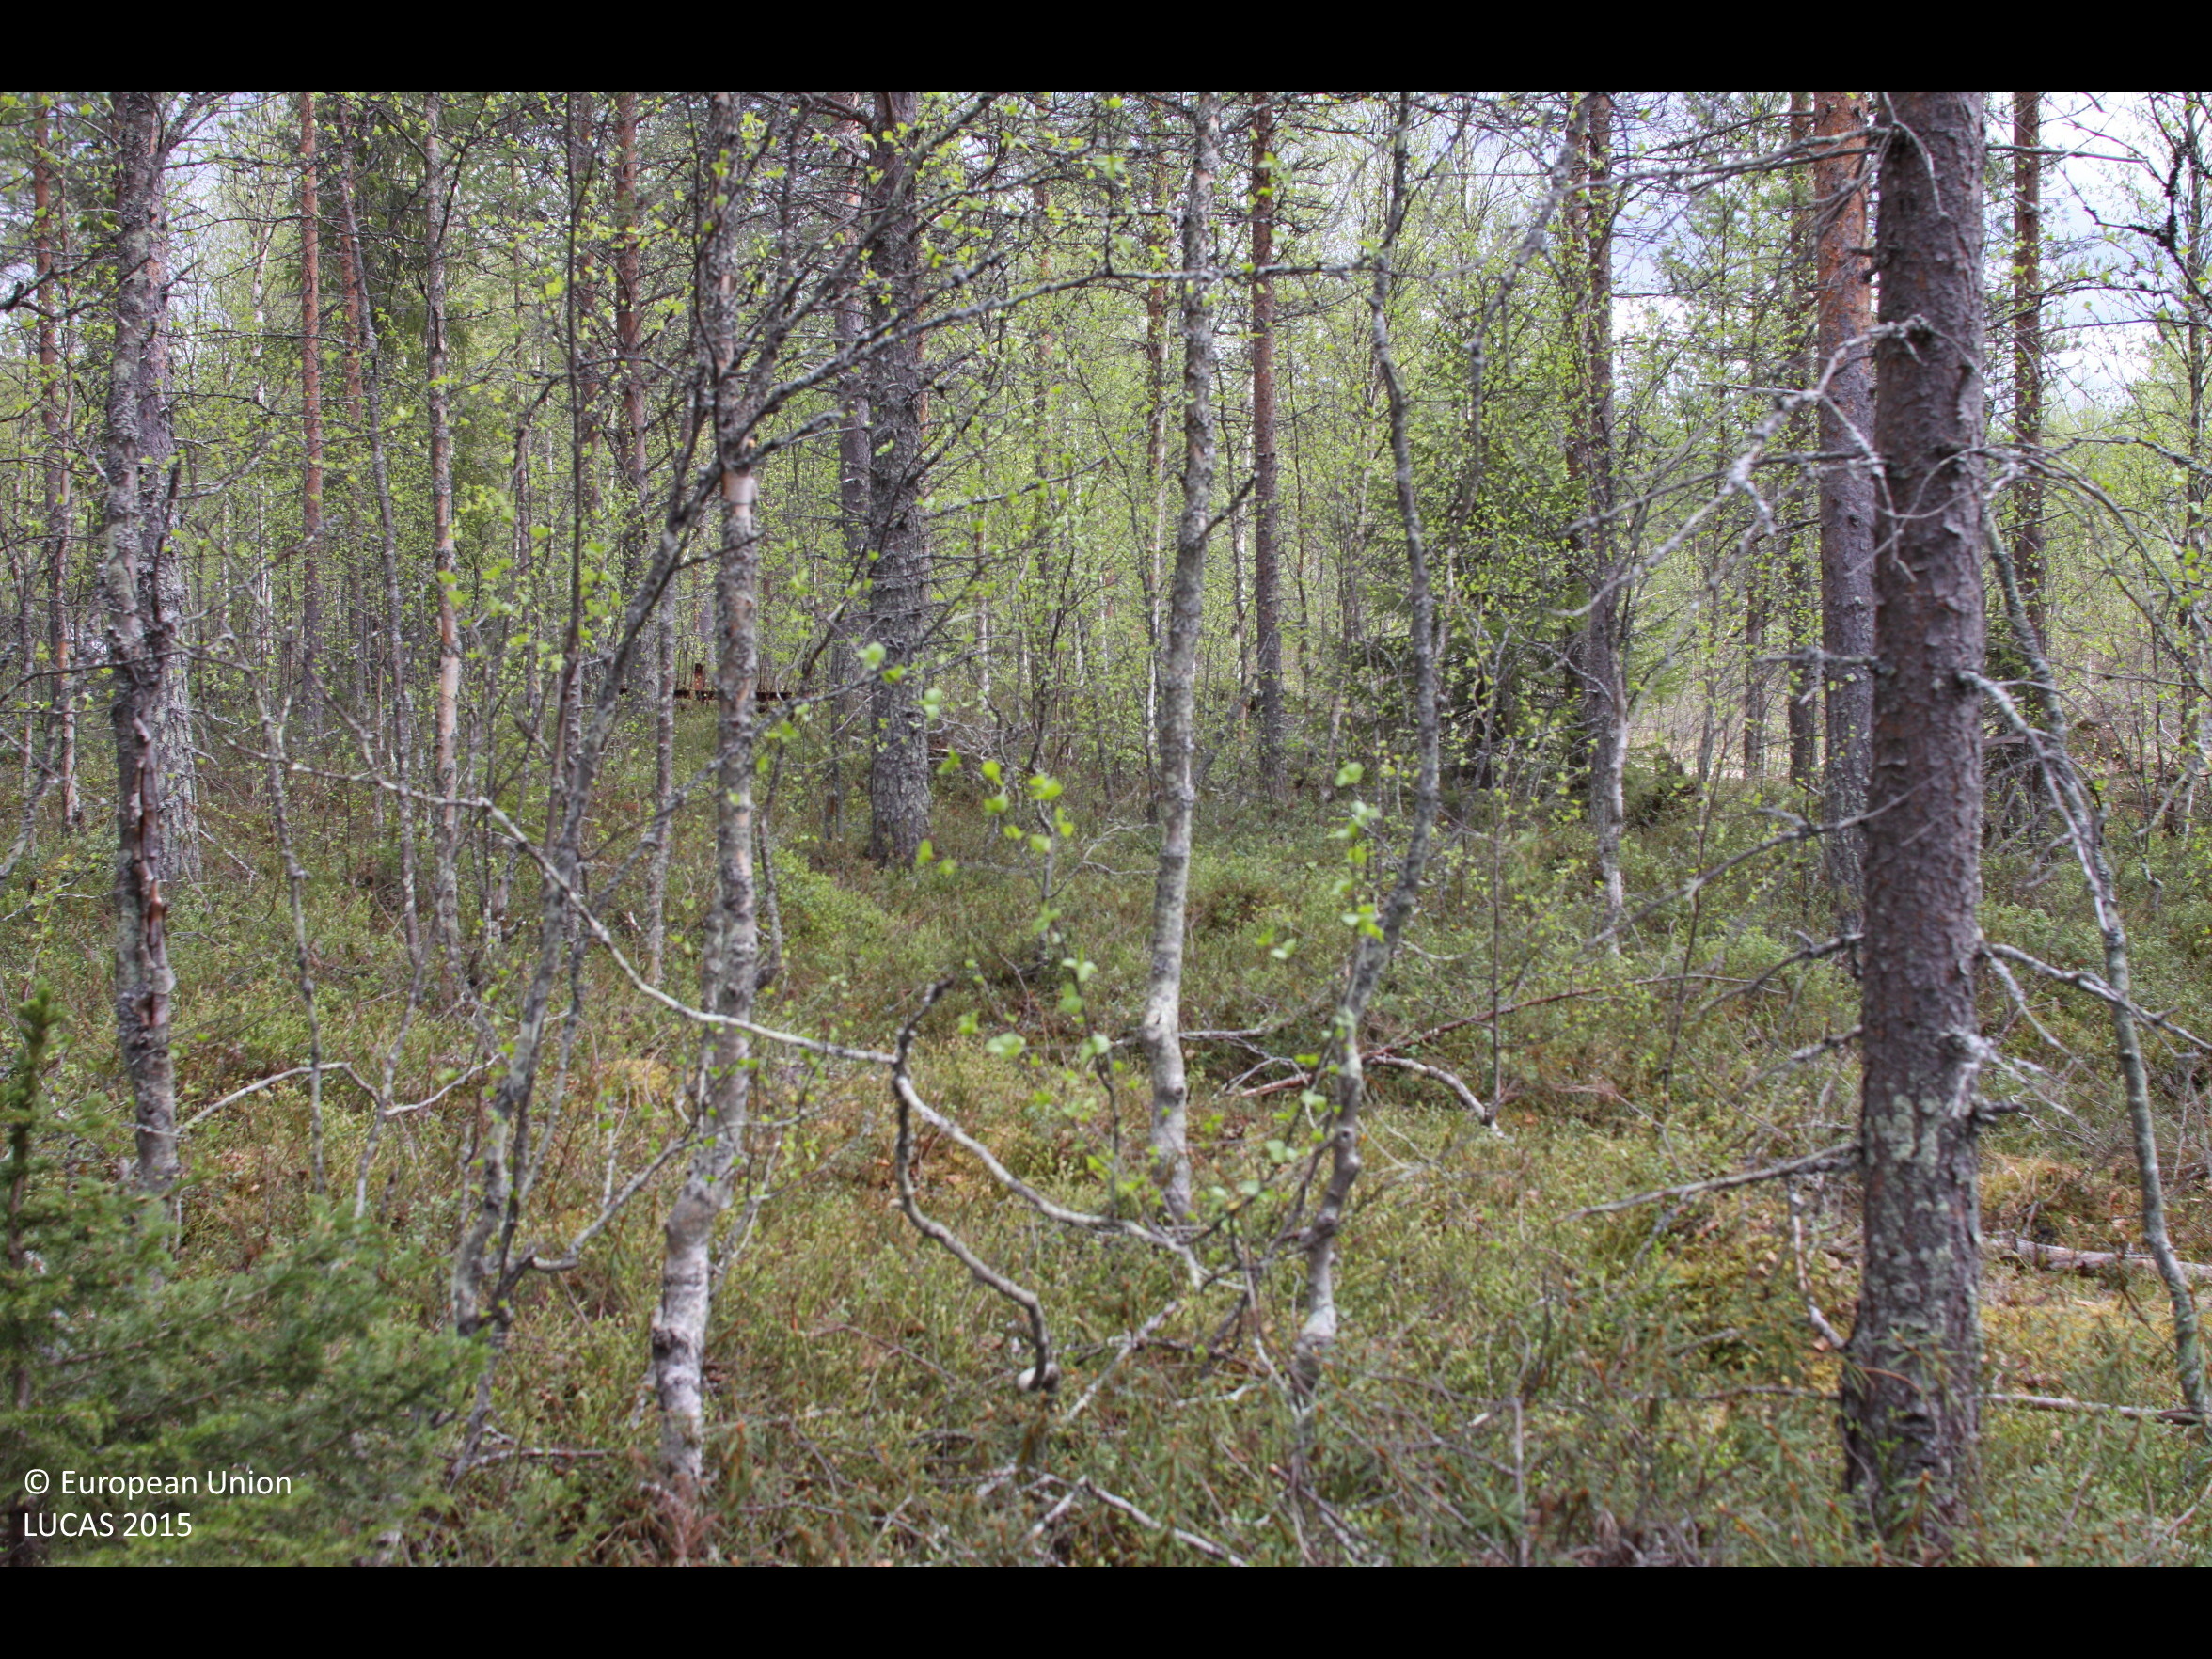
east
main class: Woodland
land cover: Pine dominated mixed woodland
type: boreal forest
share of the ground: > 75 %
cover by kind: coniferous forest trees 60 %, broadleaved forest trees 25 %, shrubs 15 %
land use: Forestry
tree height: > 5 m
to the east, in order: Pine dominated mixed woodland; Pine dominated coniferous woodland; Broadleaved woodland; Ditches and canals; Shruby margins; Electric lines; Tracks; Shruby margins; Pine dominated mixed woodland; Ditches and canals; Grass margins; Tracks; Grass margins; Ditches and canals; Pine dominated mixed woodland
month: June
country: FI
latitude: 66.2701
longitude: 27.9696
